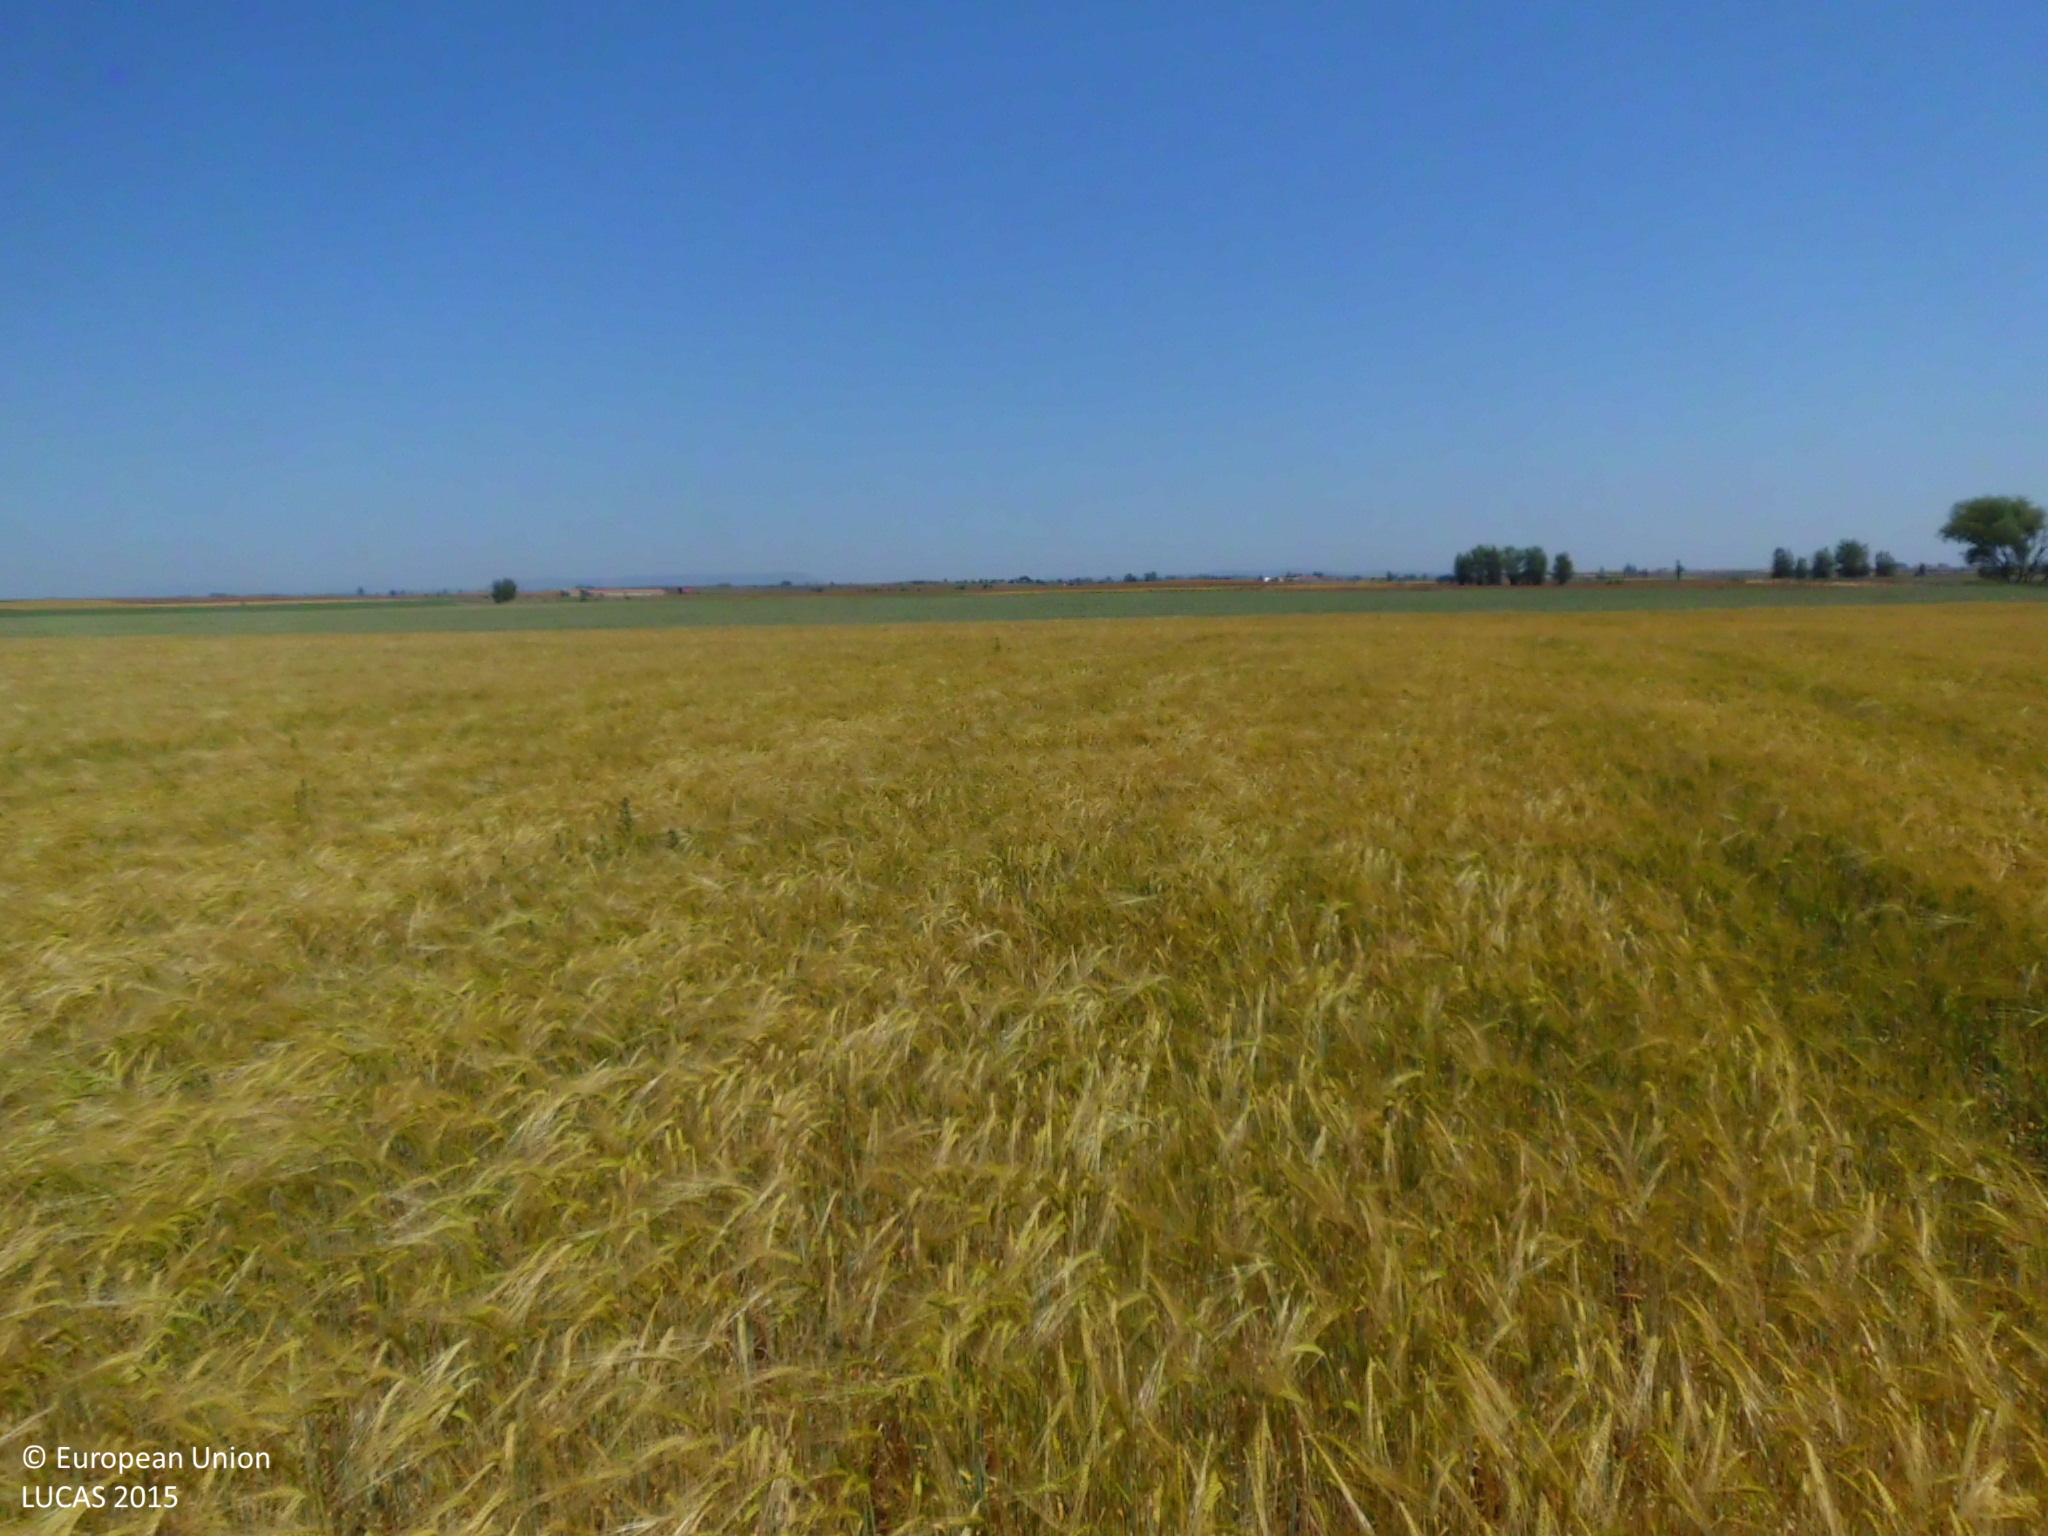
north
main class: Cropland
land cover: Barley
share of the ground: > 75 %
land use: Agriculture (excluding fallow land and kitchen gardens)
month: June
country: ES
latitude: 42.3809
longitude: -4.1940
